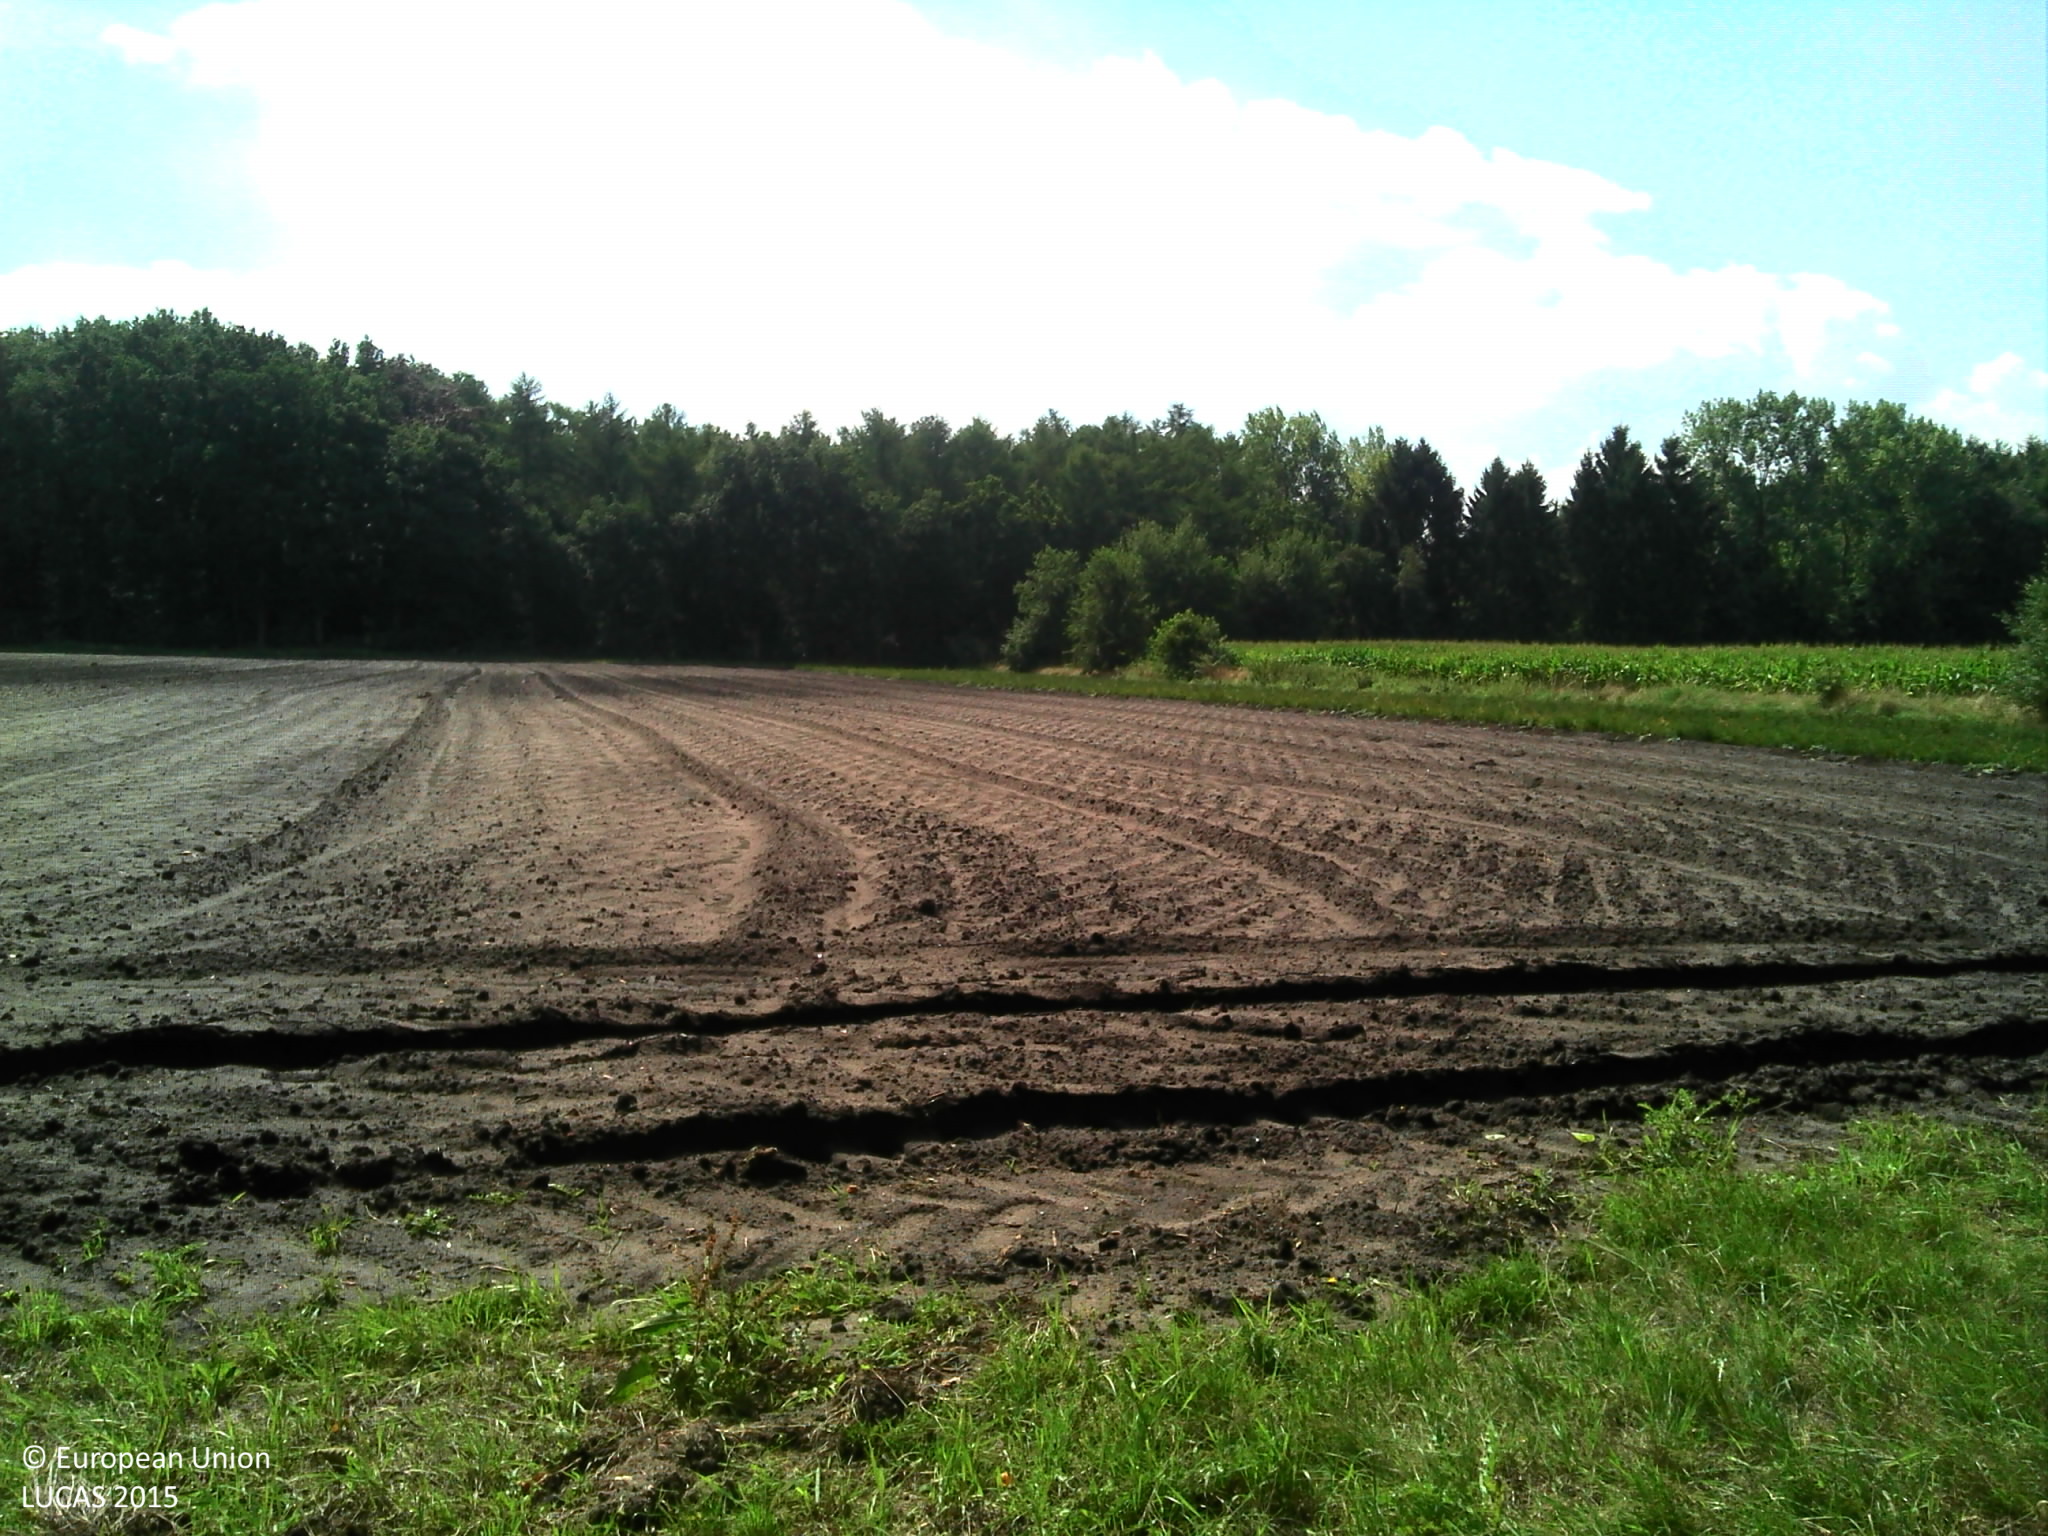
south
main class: Woodland
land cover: Broadleaved woodland
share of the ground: > 75 %
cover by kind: broadleaved forest trees 90 %, herbaceous plants 10 %
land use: Forestry
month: August
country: BE
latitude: 51.2336
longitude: 5.1423
